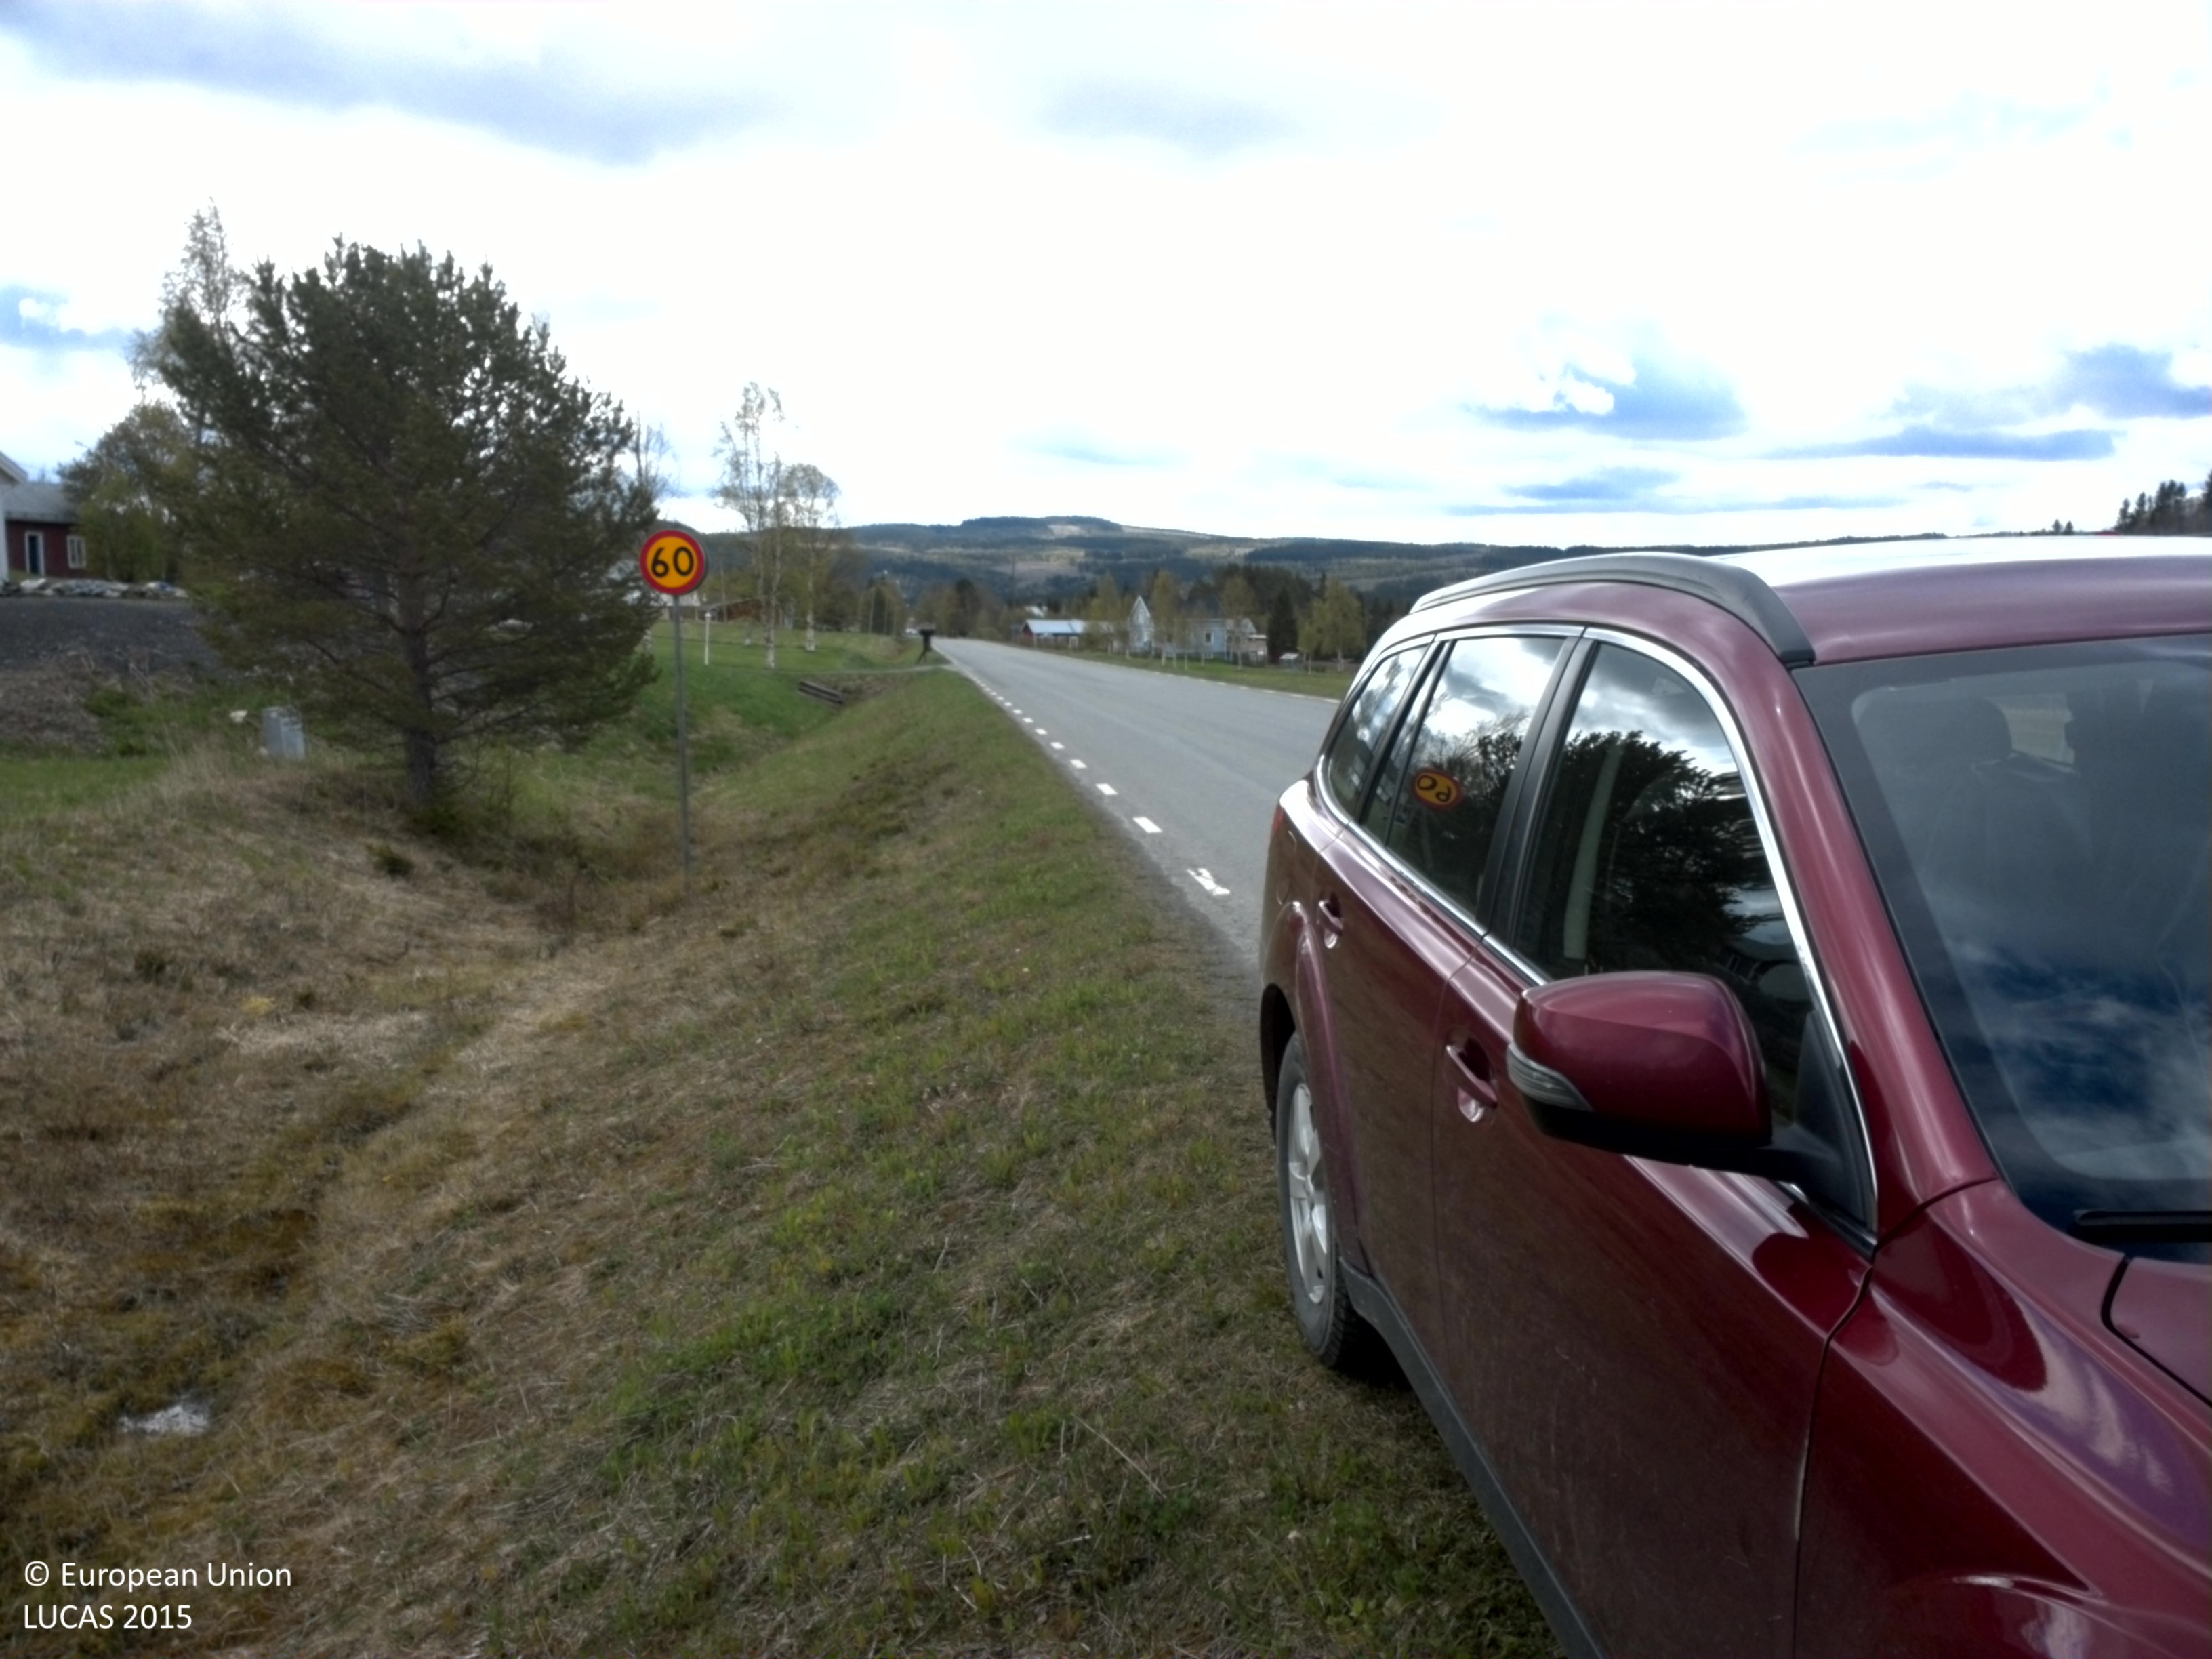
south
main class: Cropland
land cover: Other leguminous and mixtures for fodder
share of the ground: > 75 %
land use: Agriculture (excluding fallow land and kitchen gardens)
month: June
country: SE
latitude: 63.5009
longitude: 13.8973
